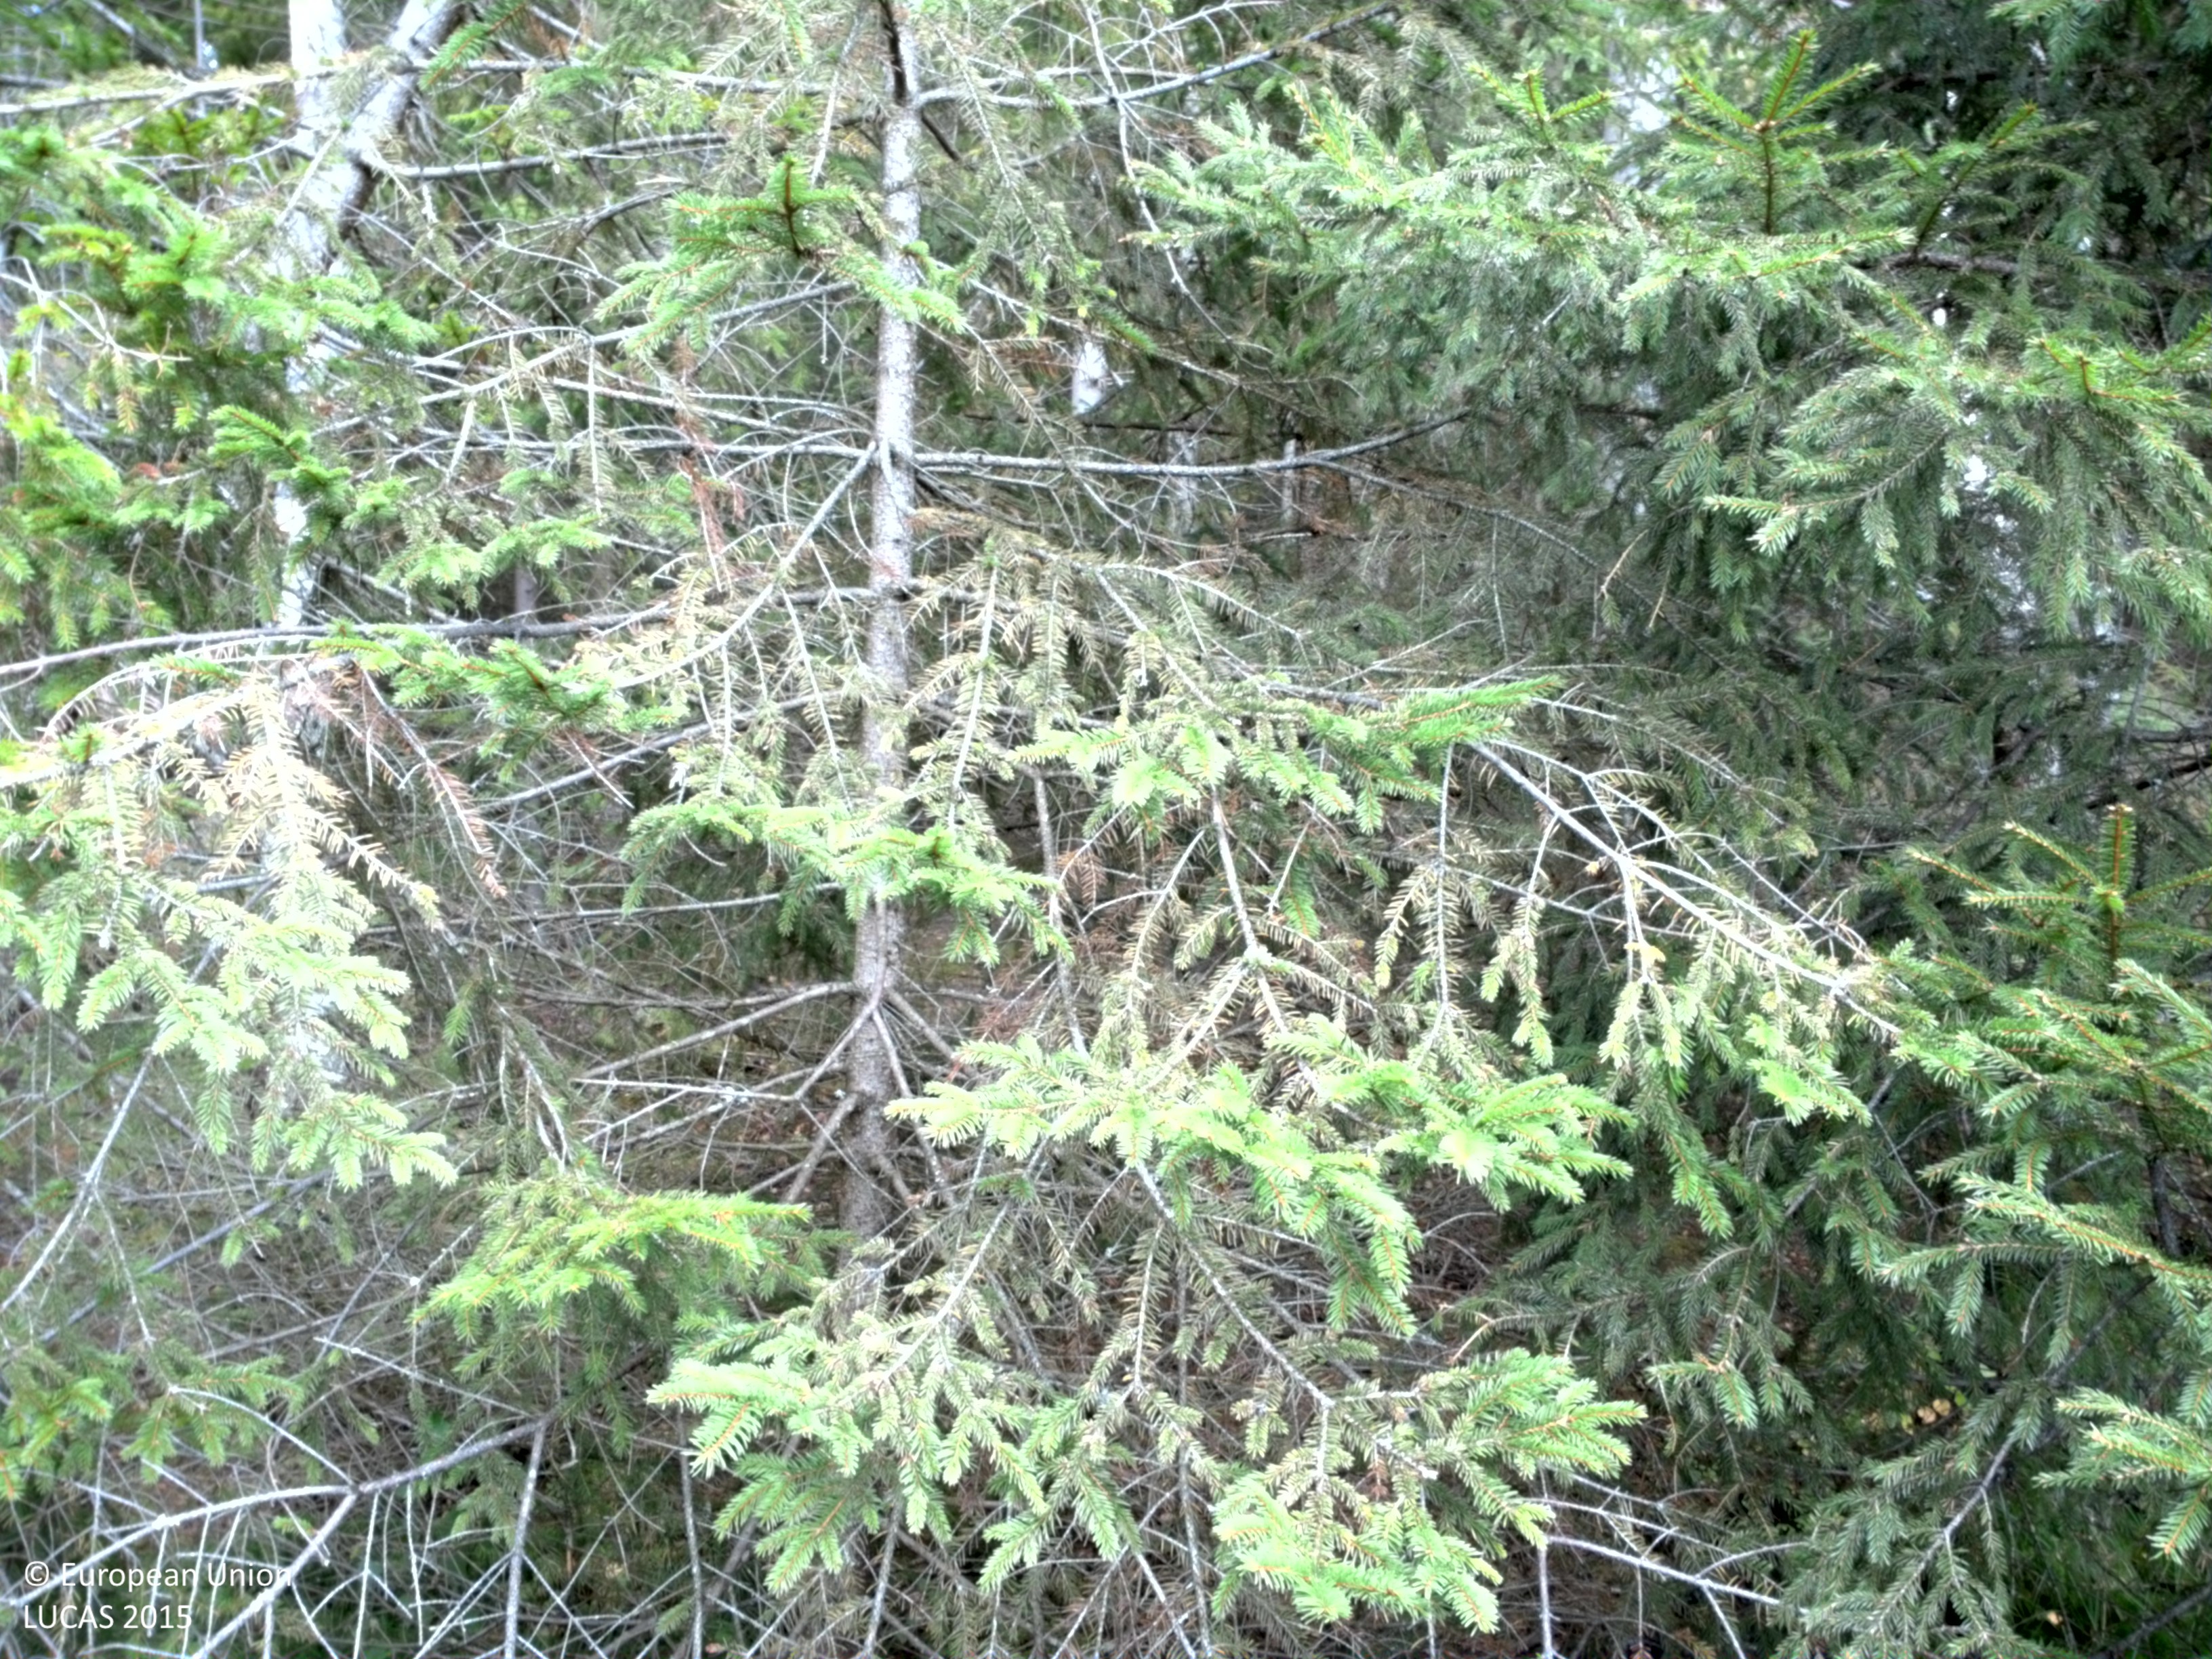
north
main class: Woodland
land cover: Spruce dominated mixed woodland
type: boreal forest
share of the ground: 25 - 50 %
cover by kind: coniferous forest trees 30 %, herbaceous plants 30 %, broadleaved forest trees 20 %, shrubs 20 %
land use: Forestry
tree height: > 5 m
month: September
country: SE
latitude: 58.1305
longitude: 13.0684
